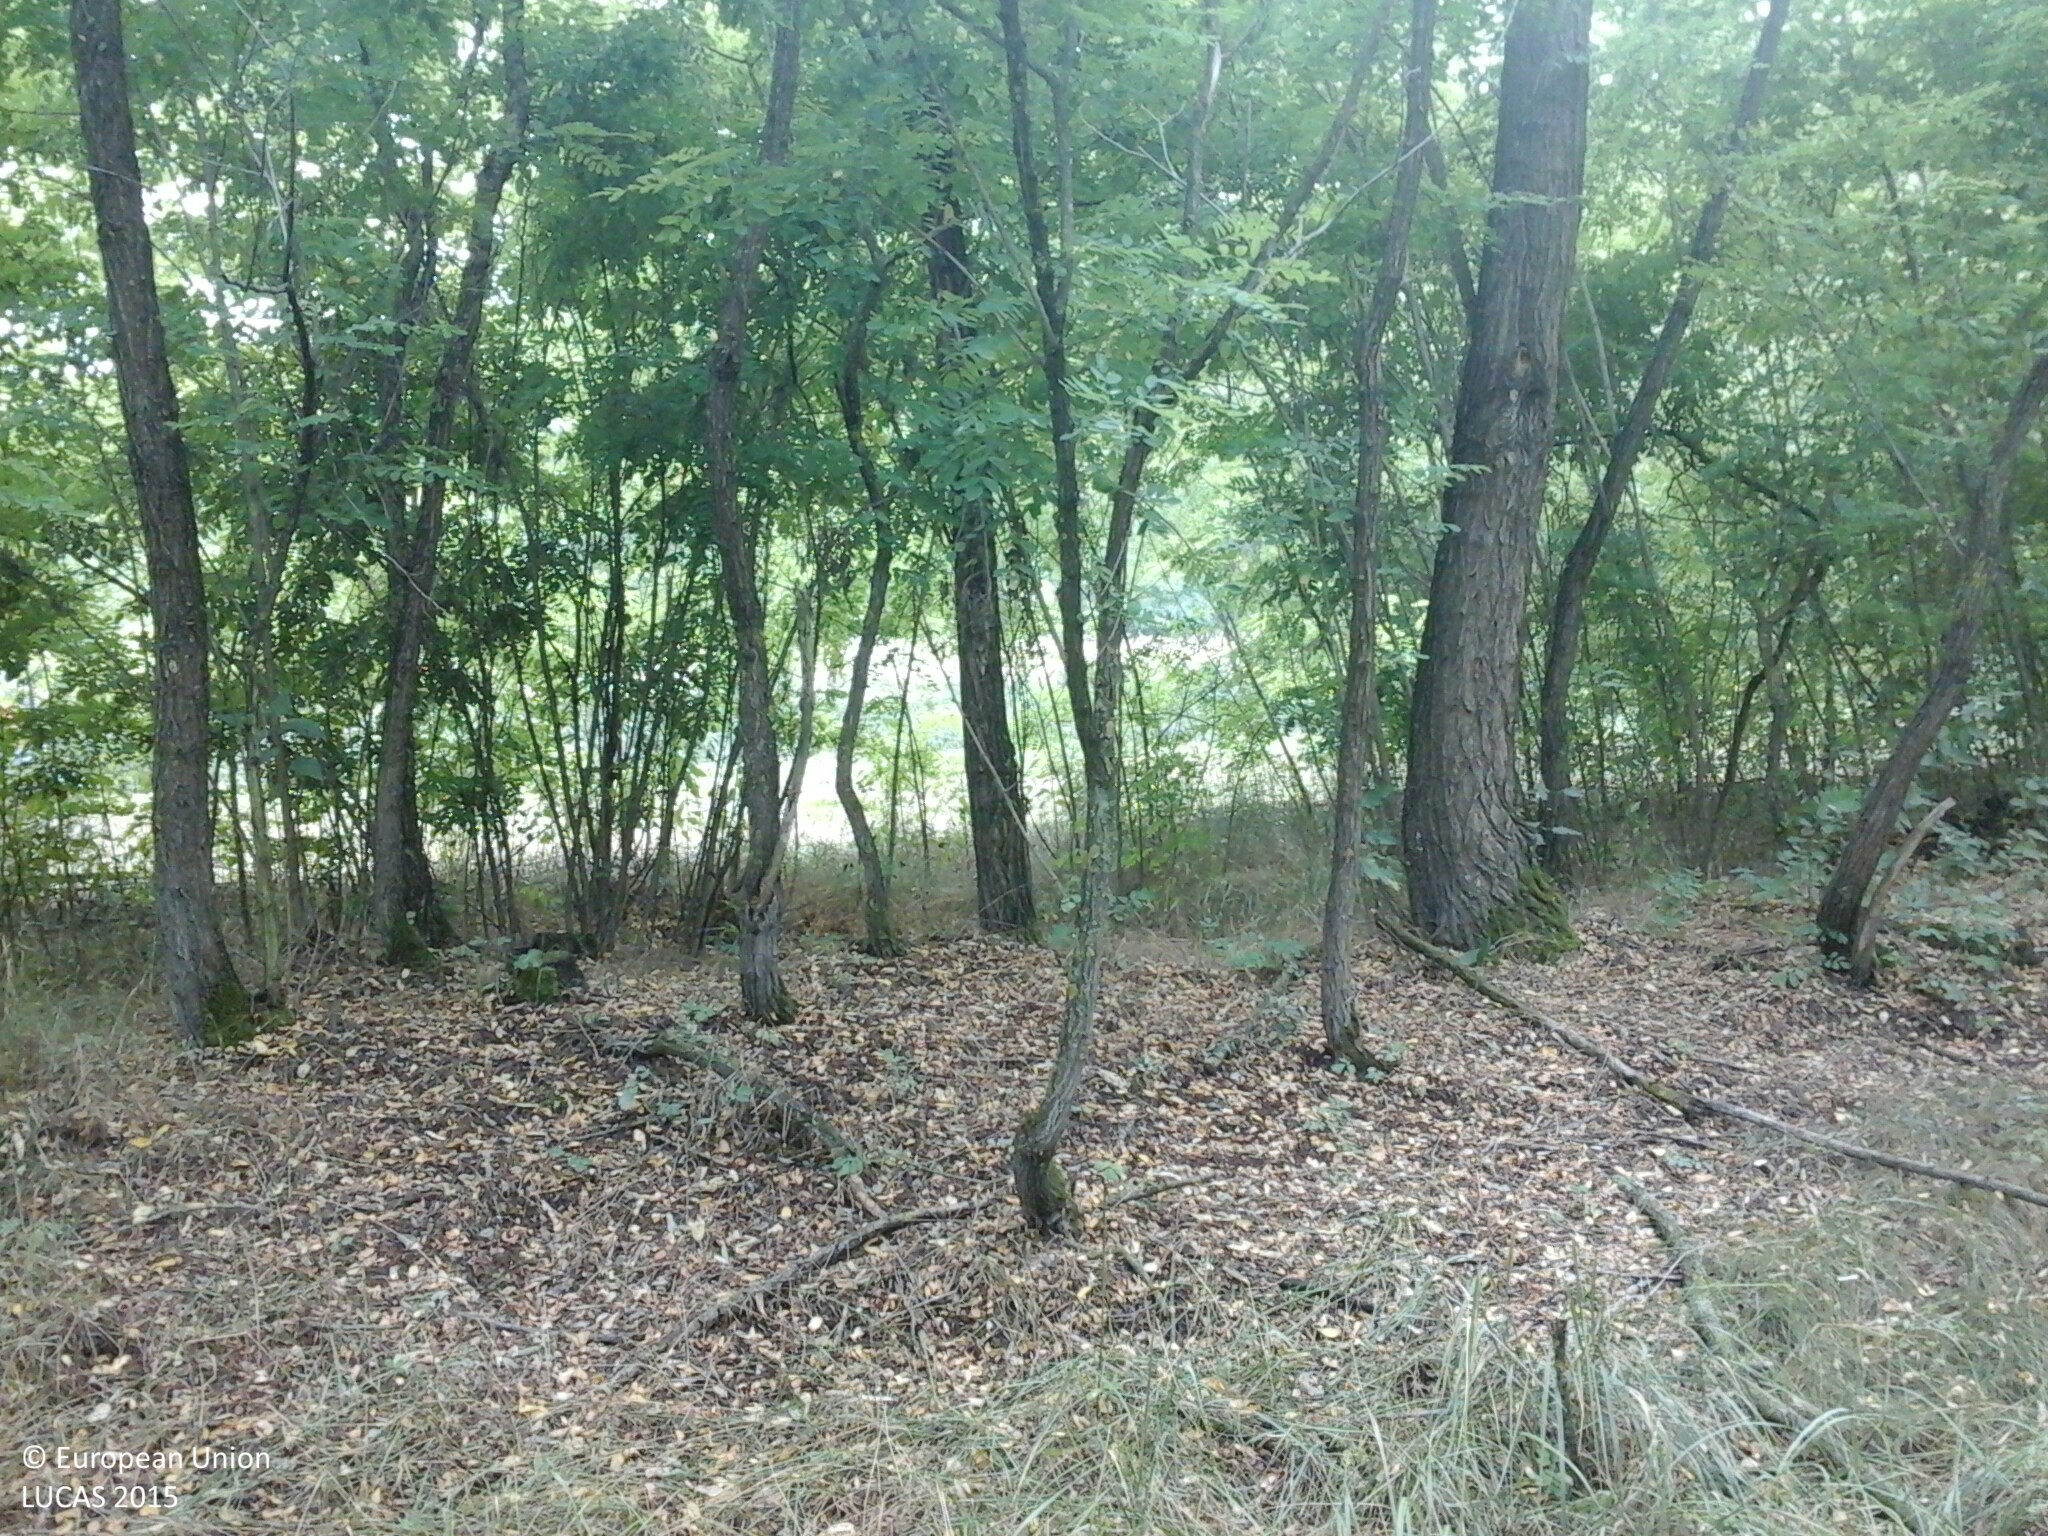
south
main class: Woodland
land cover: Broadleaved woodland
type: exotic forest
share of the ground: > 75 %
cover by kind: broadleaved forest trees 95 %, herbaceous plants 5 %
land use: Forestry
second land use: Agriculture (excluding fallow land and kitchen gardens)
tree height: > 5 m
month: July
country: HU
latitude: 48.1768
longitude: 22.2271
